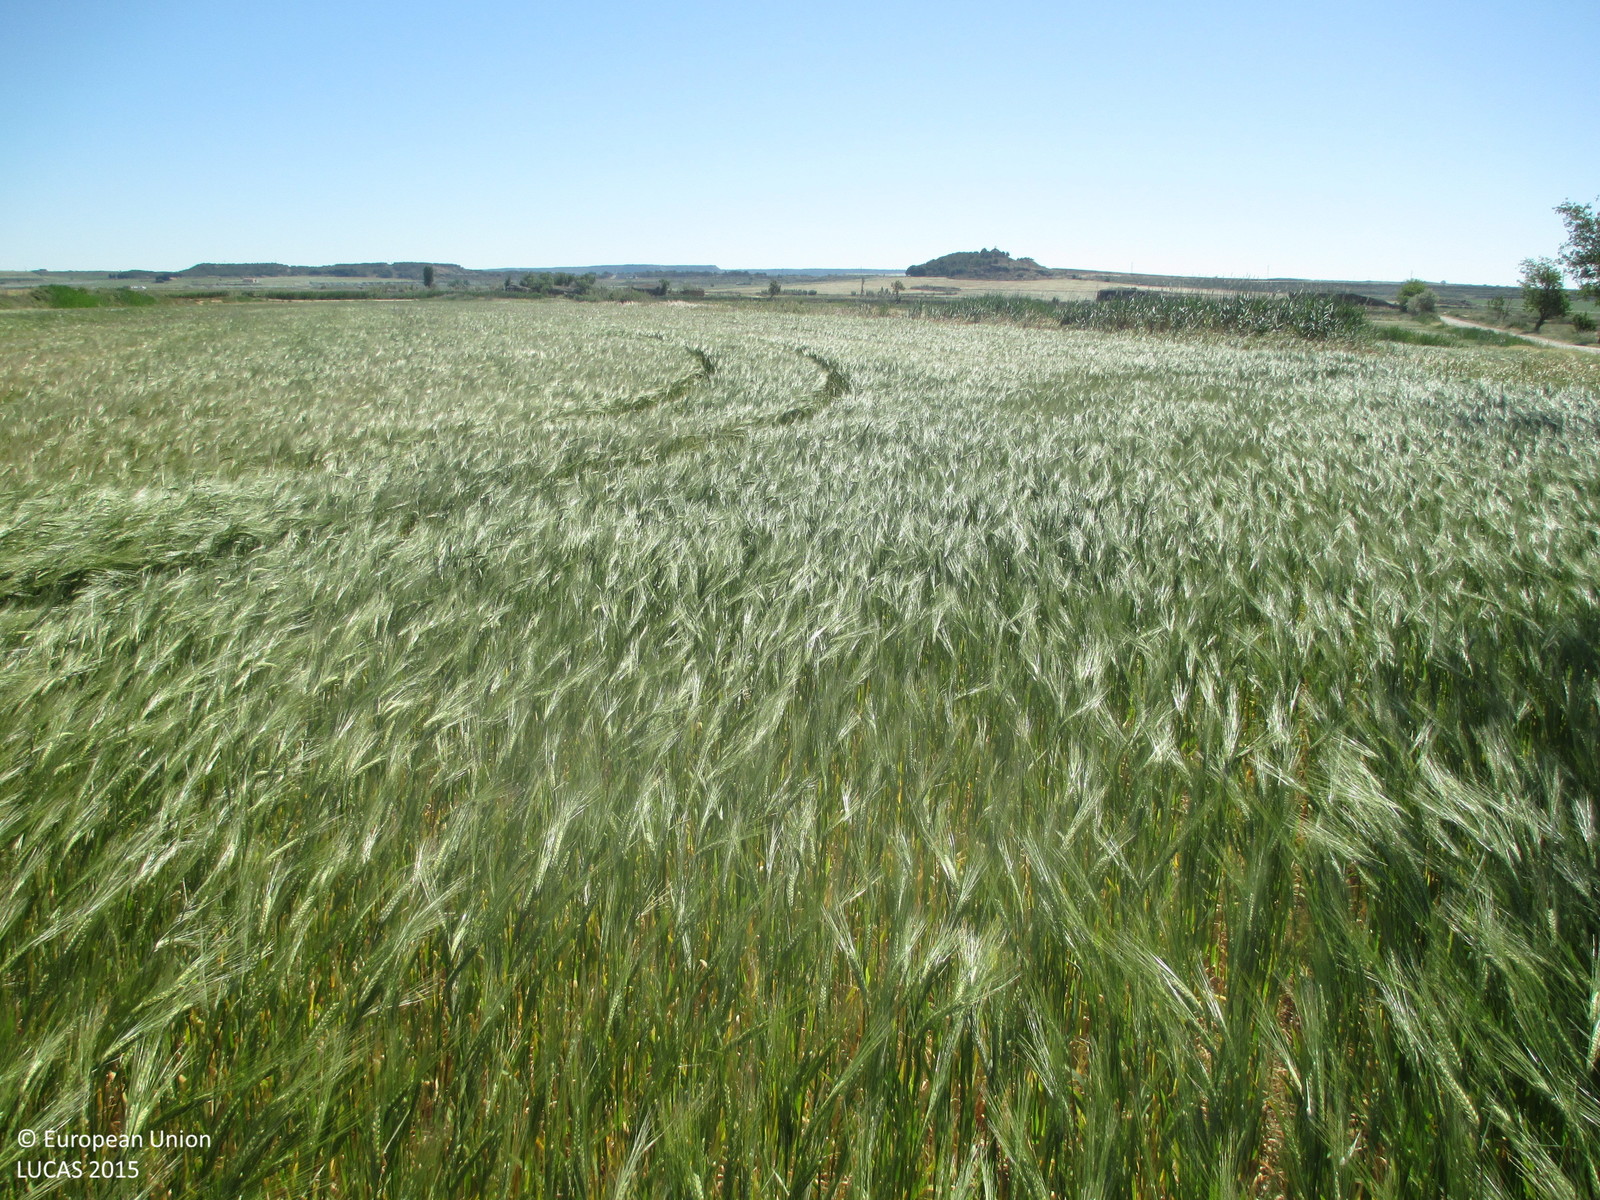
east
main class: Cropland
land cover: Barley
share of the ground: > 75 %
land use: Agriculture (excluding fallow land and kitchen gardens)
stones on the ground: < 10 %
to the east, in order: Barley; Shruby margins; Barley; Shruby margins; Barley; Grass margins; Tracks; Shruby margins; Spontaneously vegetated surfaces
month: May
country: ES
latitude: 41.8675
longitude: -0.1750
